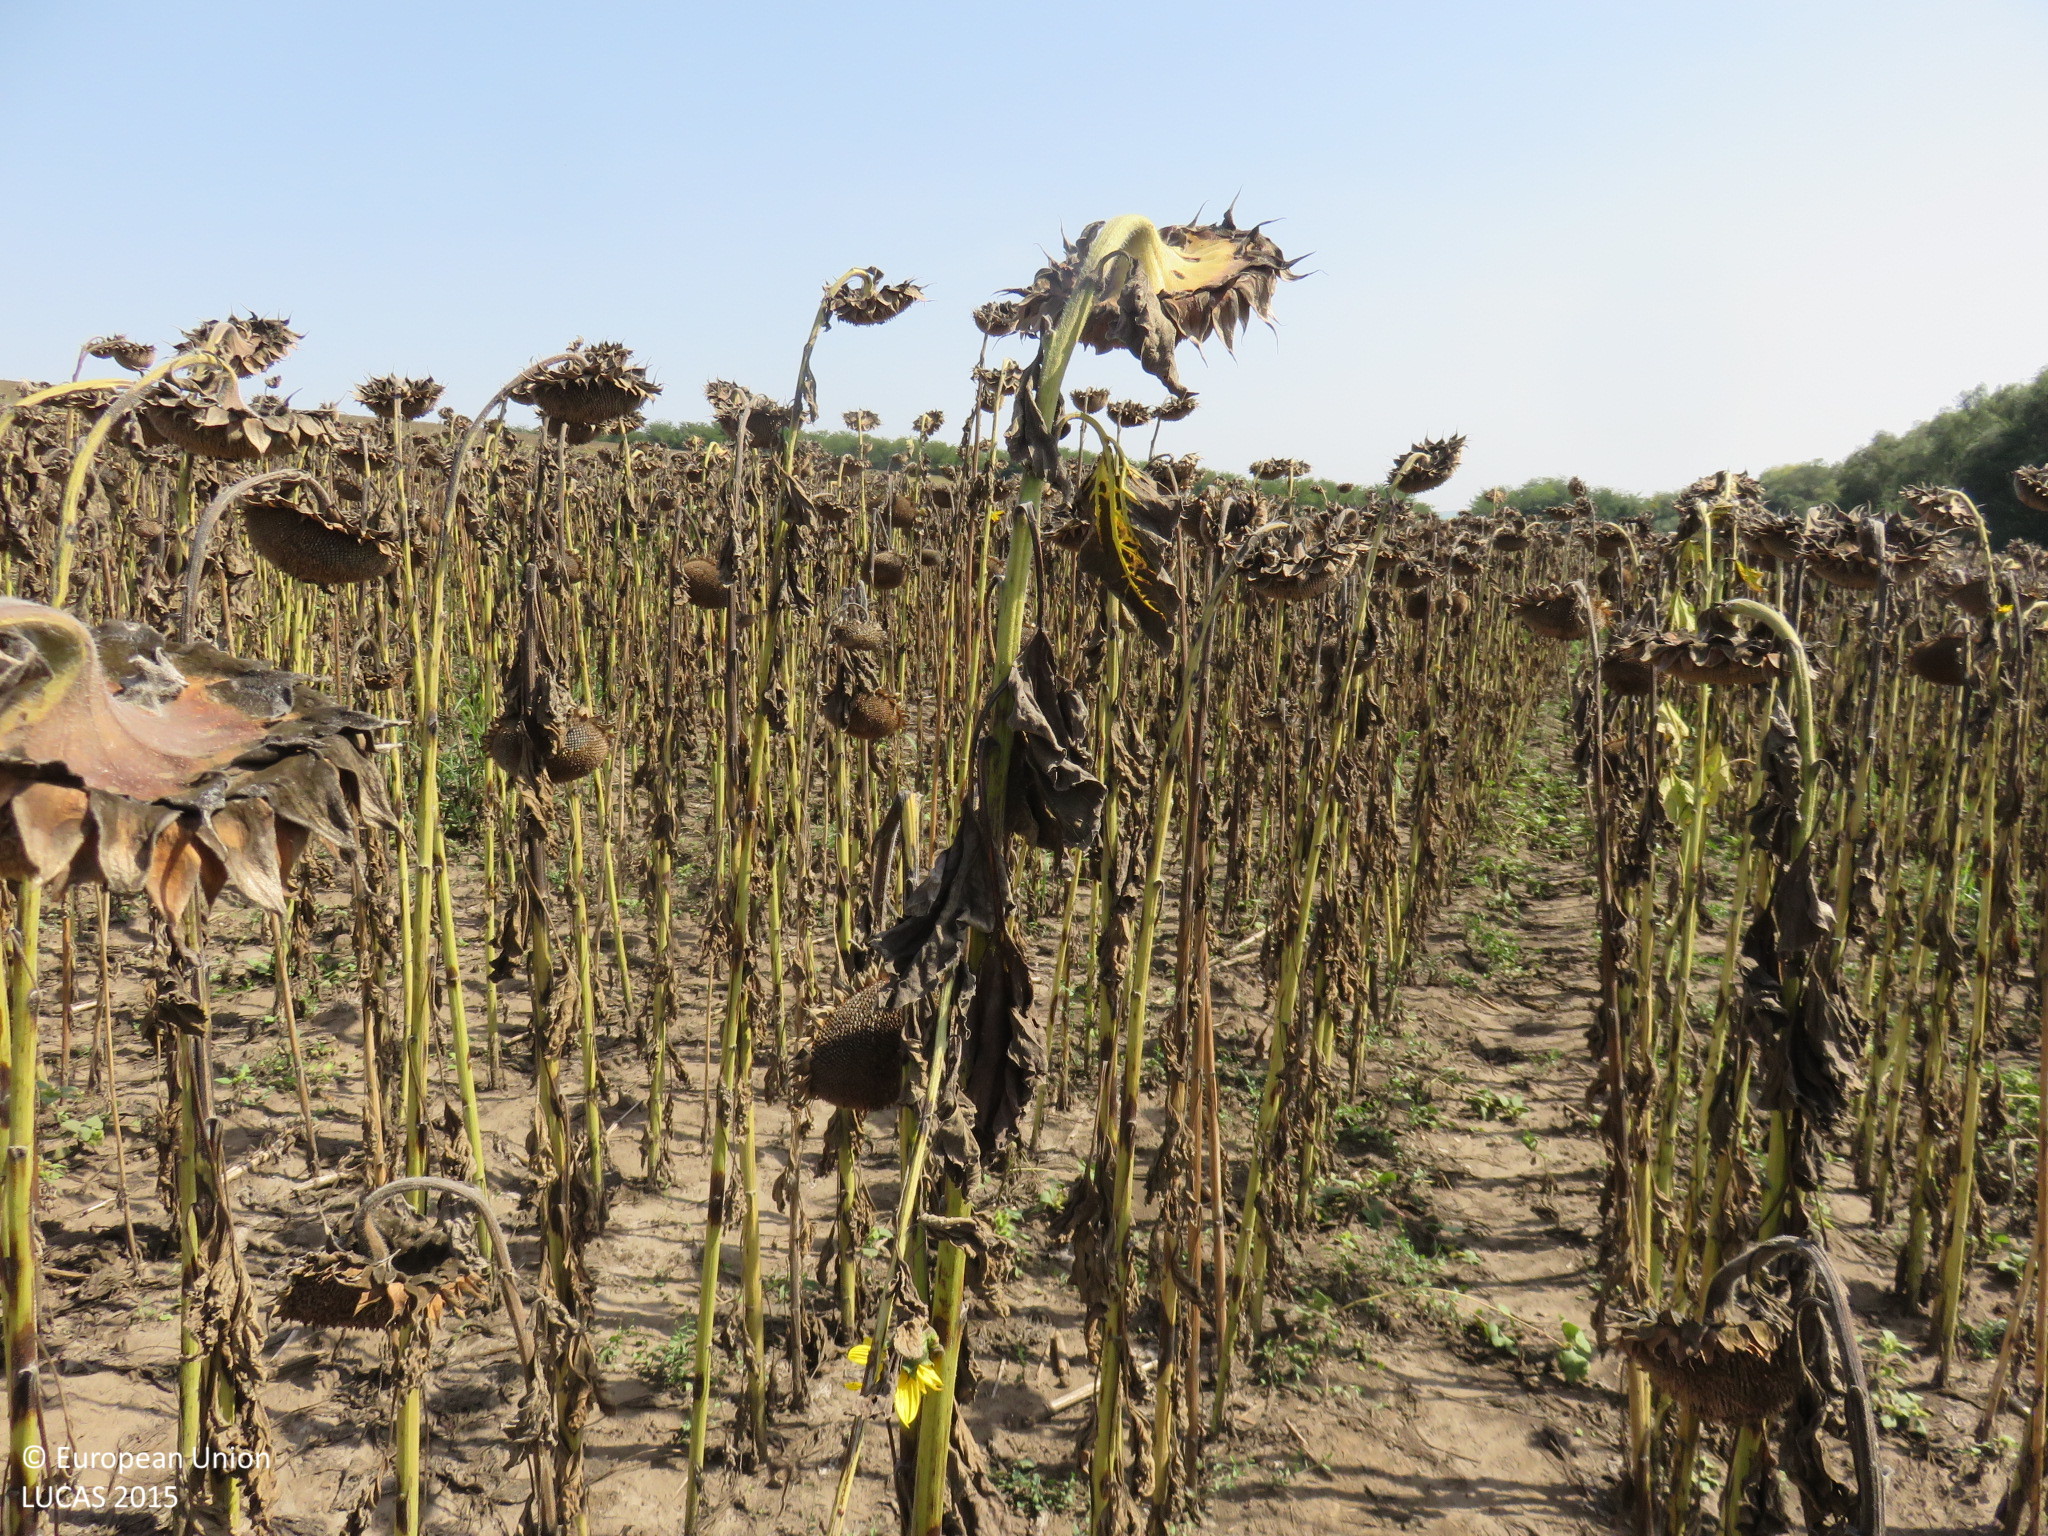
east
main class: Cropland
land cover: Sunflower
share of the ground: > 75 %
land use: Agriculture (excluding fallow land and kitchen gardens)
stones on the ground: < 10 %
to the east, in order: Sunflower; Grass margins; Tracks; Grassland without tree/shrub cover; Sunflower
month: September
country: BG
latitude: 43.5588
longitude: 24.5345
